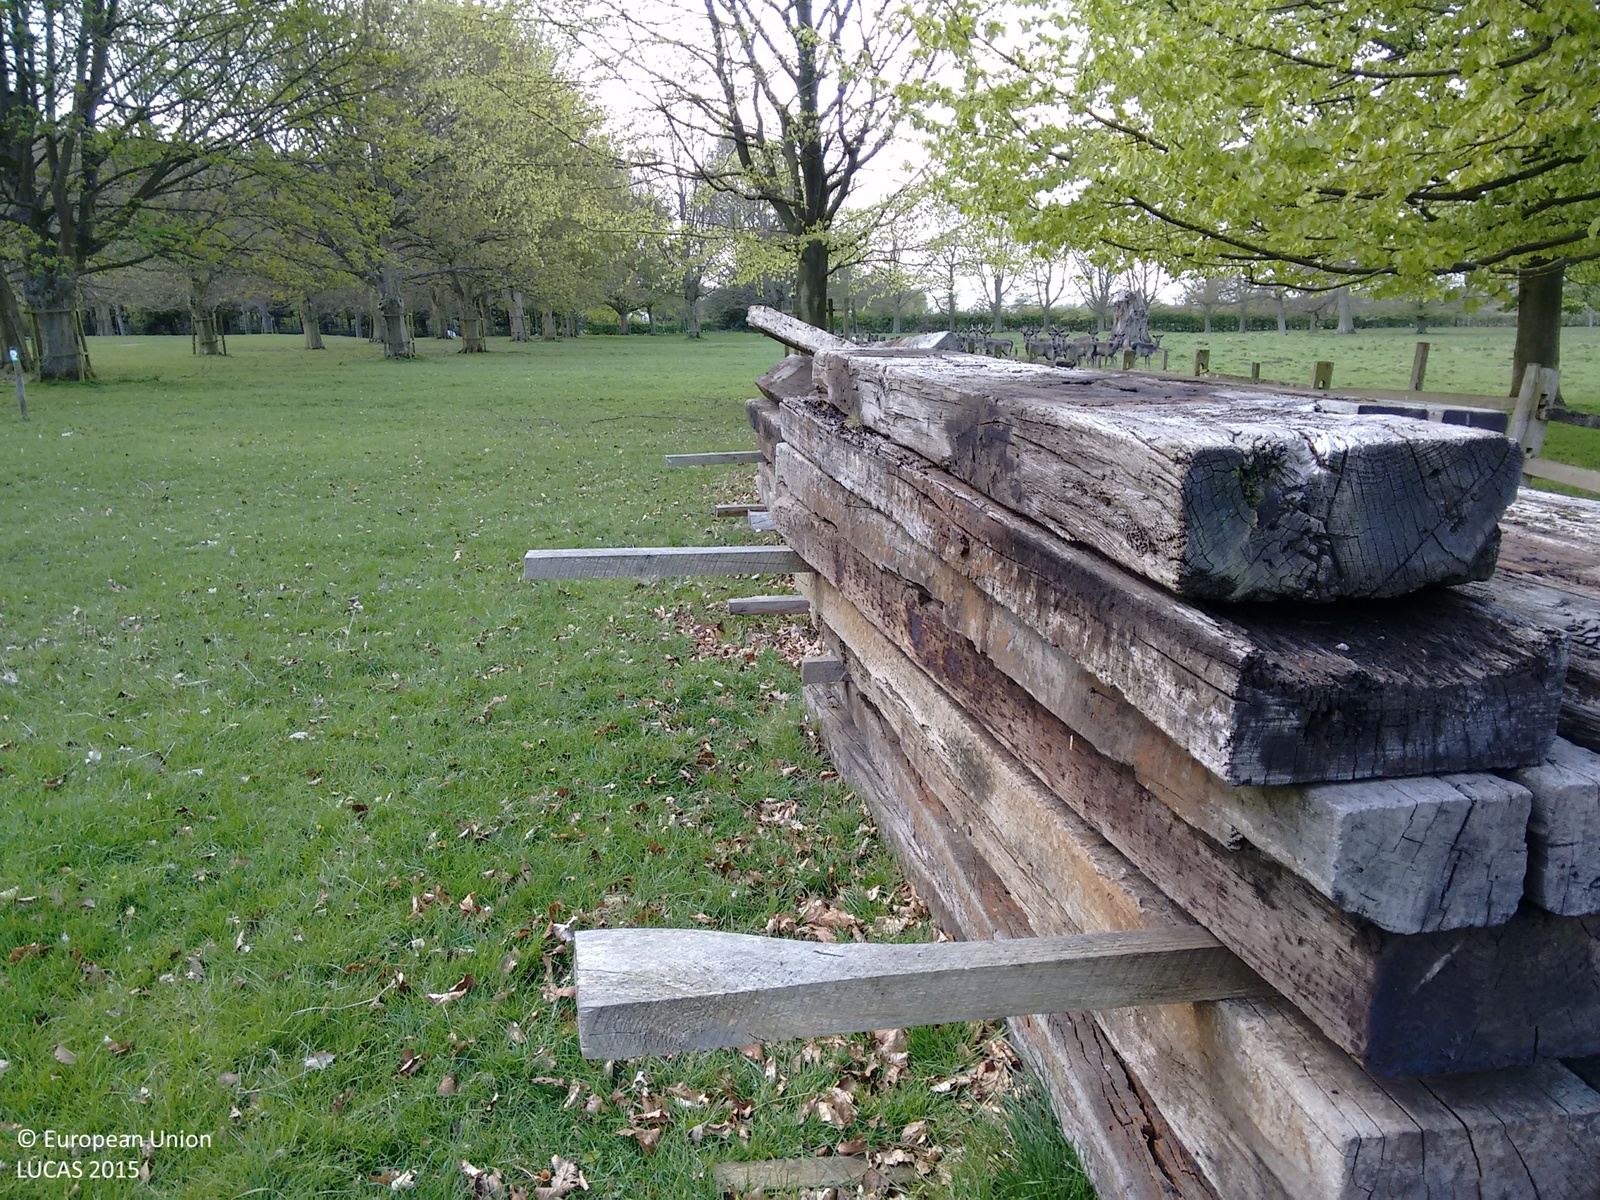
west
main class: Grassland
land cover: Grassland without tree/shrub cover
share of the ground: > 75 %
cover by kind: herbaceous plants 100 %
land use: Agriculture (excluding fallow land and kitchen gardens)
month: April
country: GB
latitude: 53.1777
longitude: -0.1027
